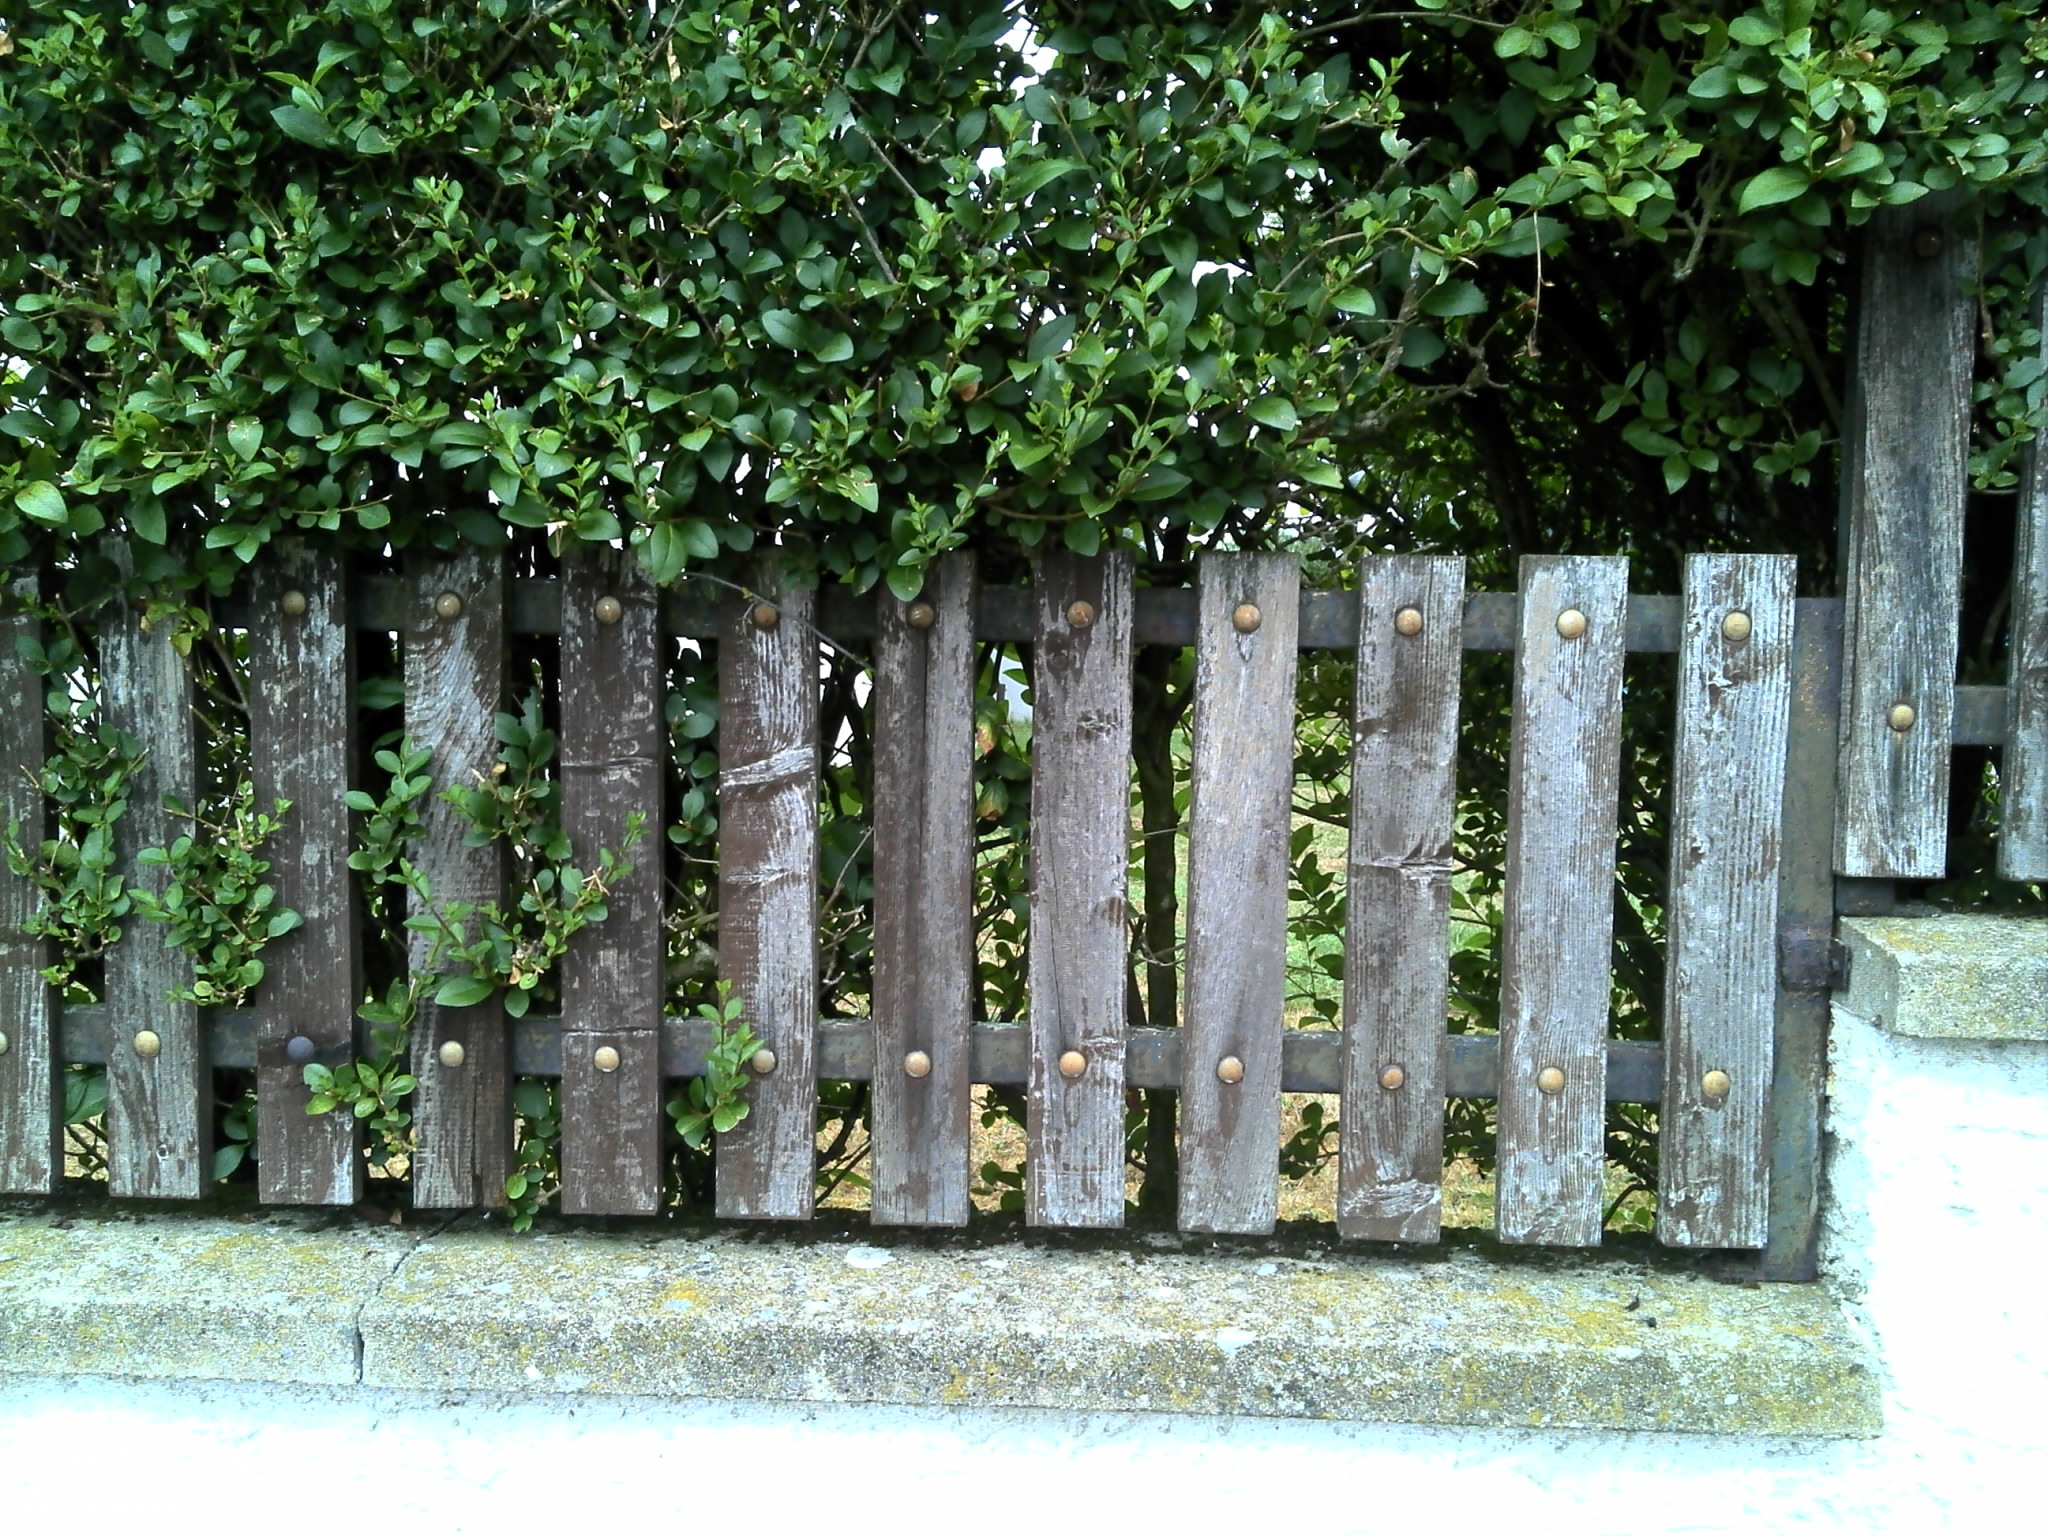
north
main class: Grassland
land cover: Grassland without tree/shrub cover
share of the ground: > 75 %
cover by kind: herbaceous plants 100 %
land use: Residential
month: August
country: FR
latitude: 46.1514
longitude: 4.0842
